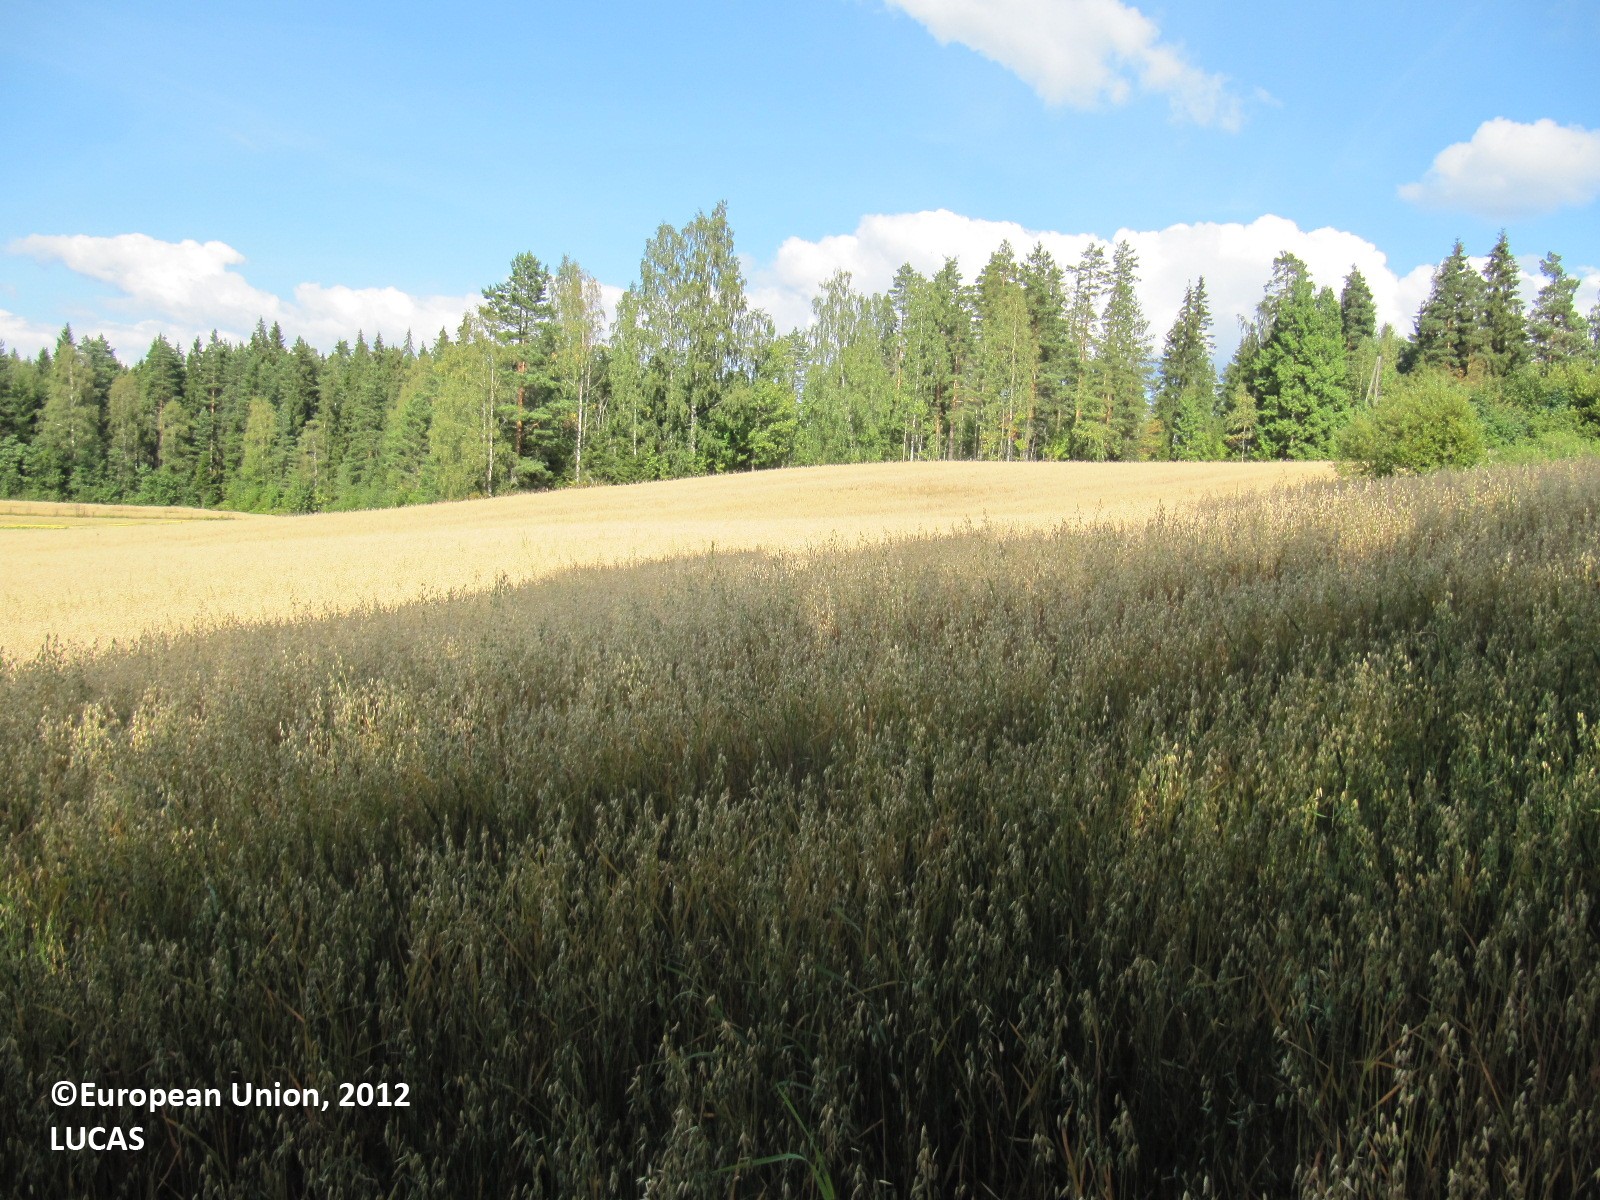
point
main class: Cropland
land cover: Oats
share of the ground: > 75 %
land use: Agriculture (excluding fallow land and kitchen gardens)
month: August
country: FI
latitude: 60.6451
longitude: 24.4225
